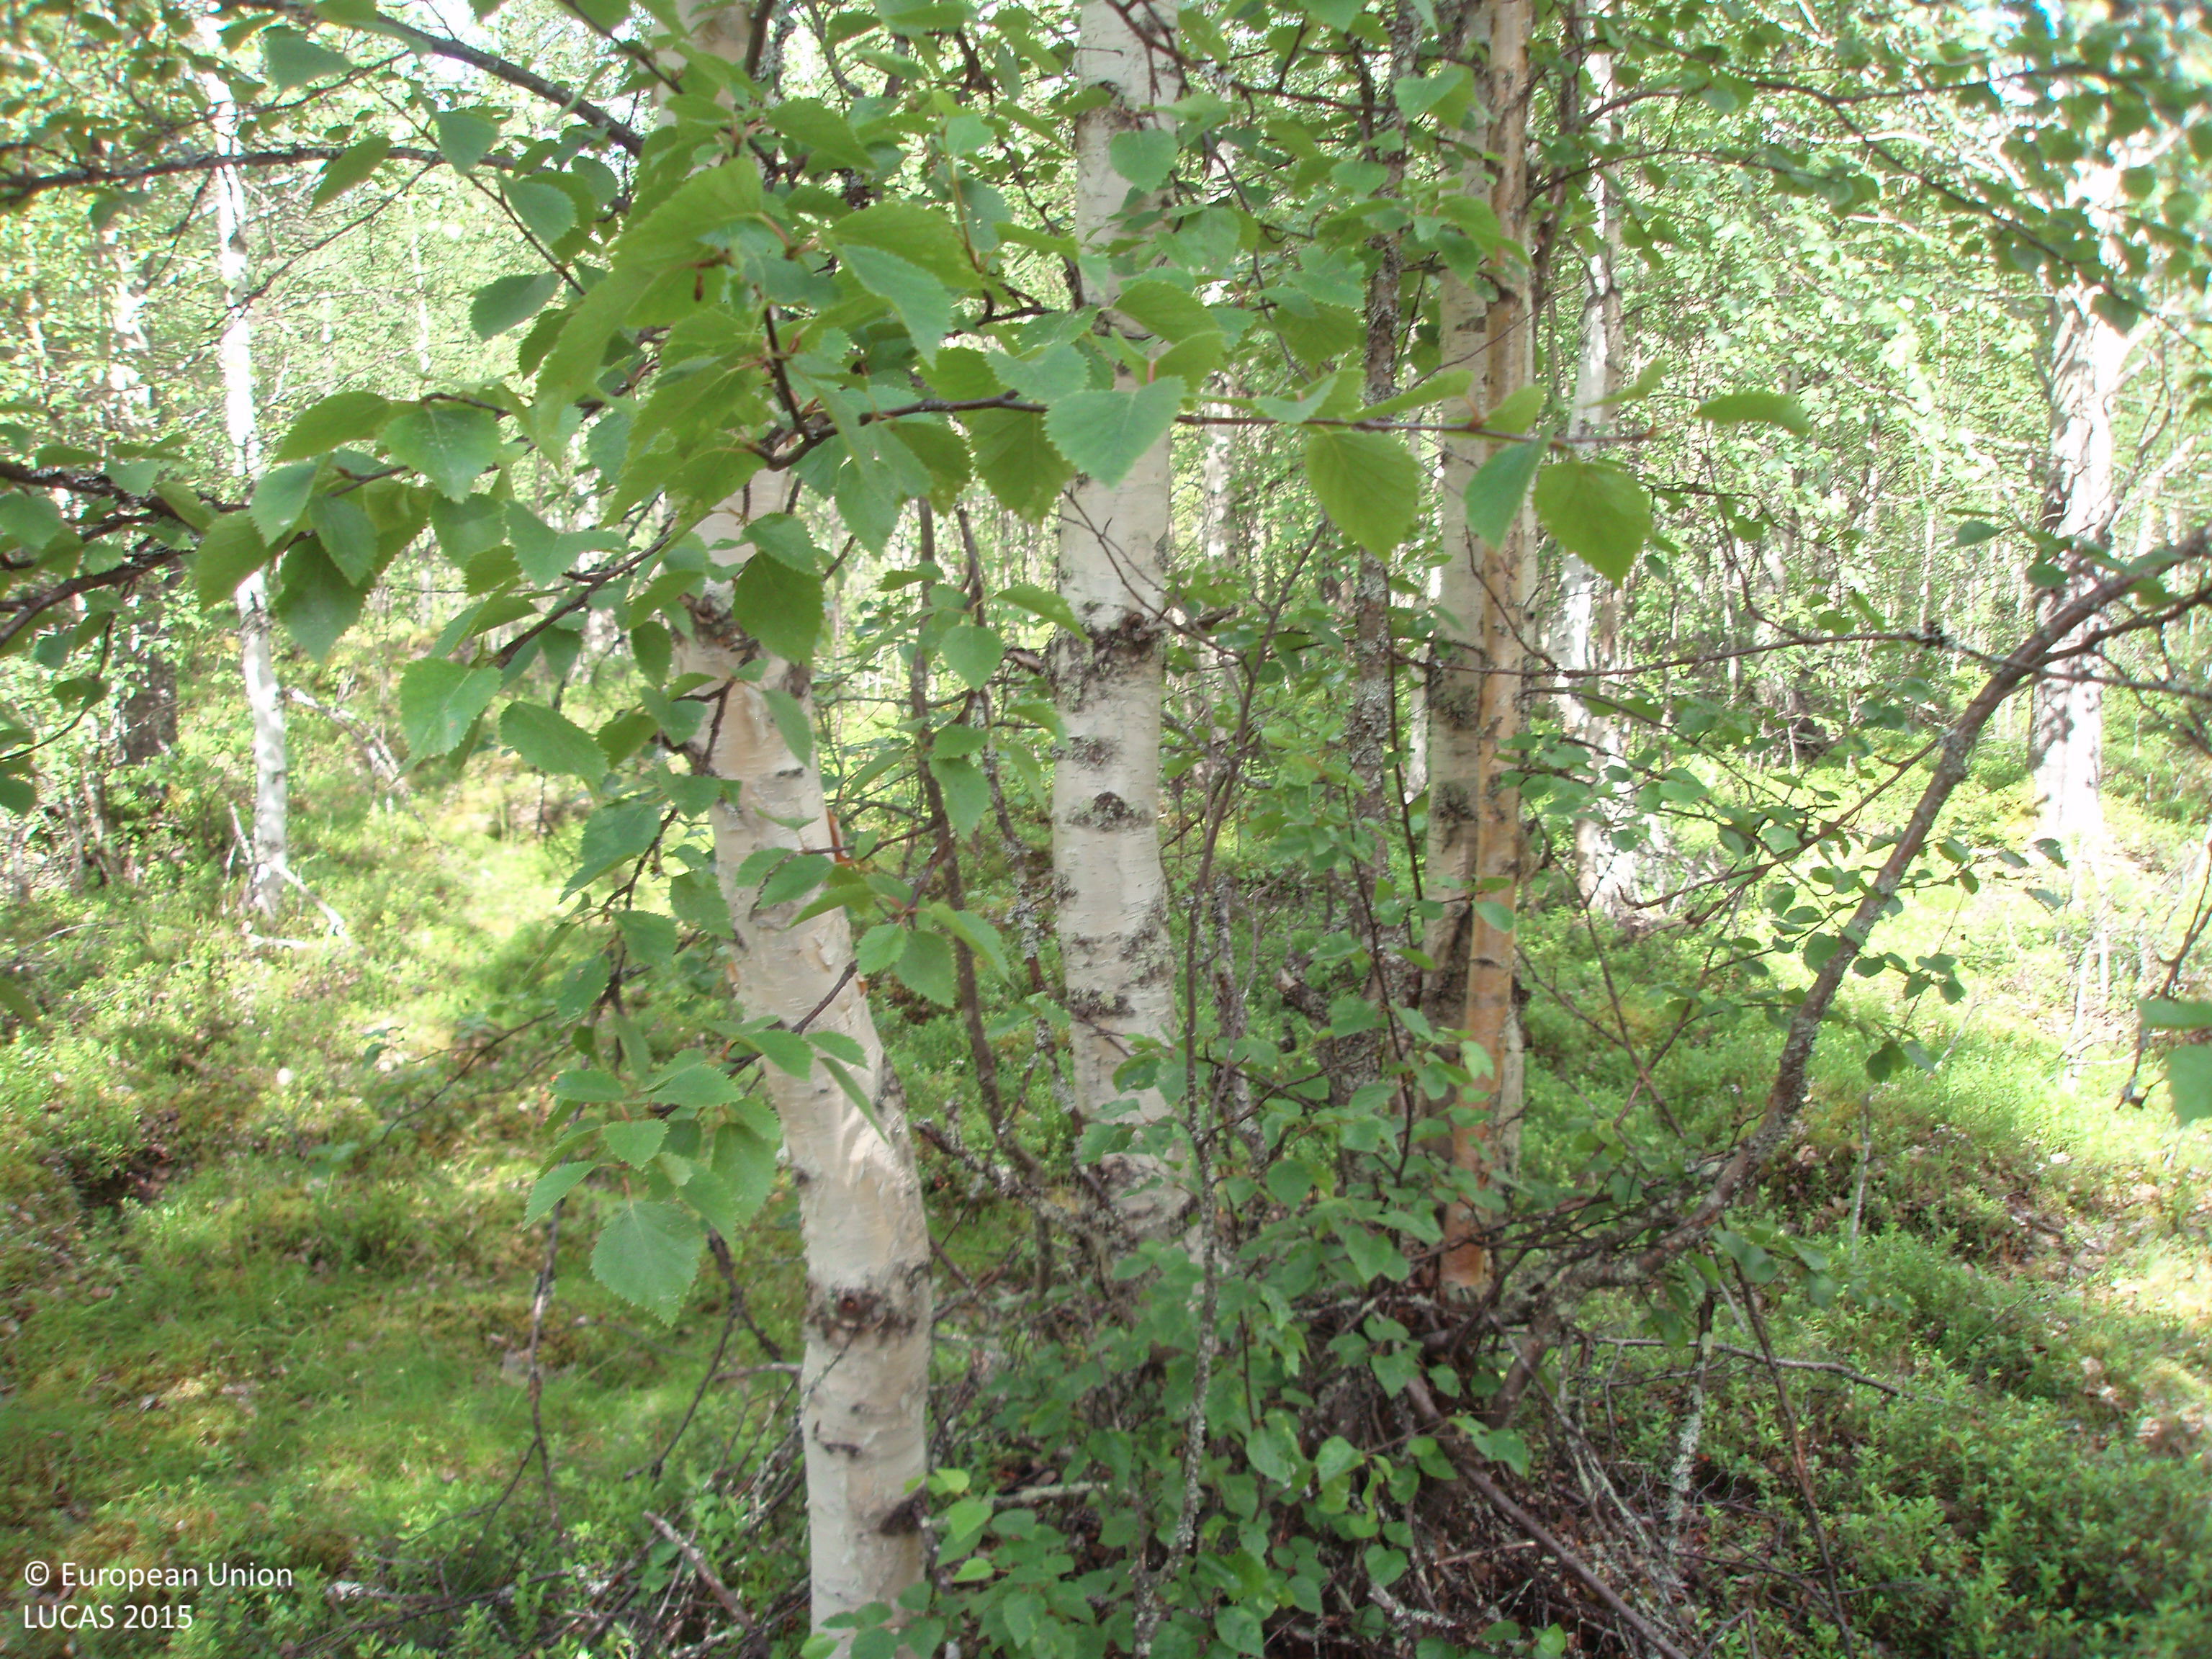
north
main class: Woodland
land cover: Broadleaved woodland
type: boreal forest
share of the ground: > 75 %
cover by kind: broadleaved forest trees 75 %, shrubs 20 %, coniferous forest trees 5 %
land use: Forestry
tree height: > 5 m
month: July
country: FI
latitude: 66.9529
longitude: 28.2357
